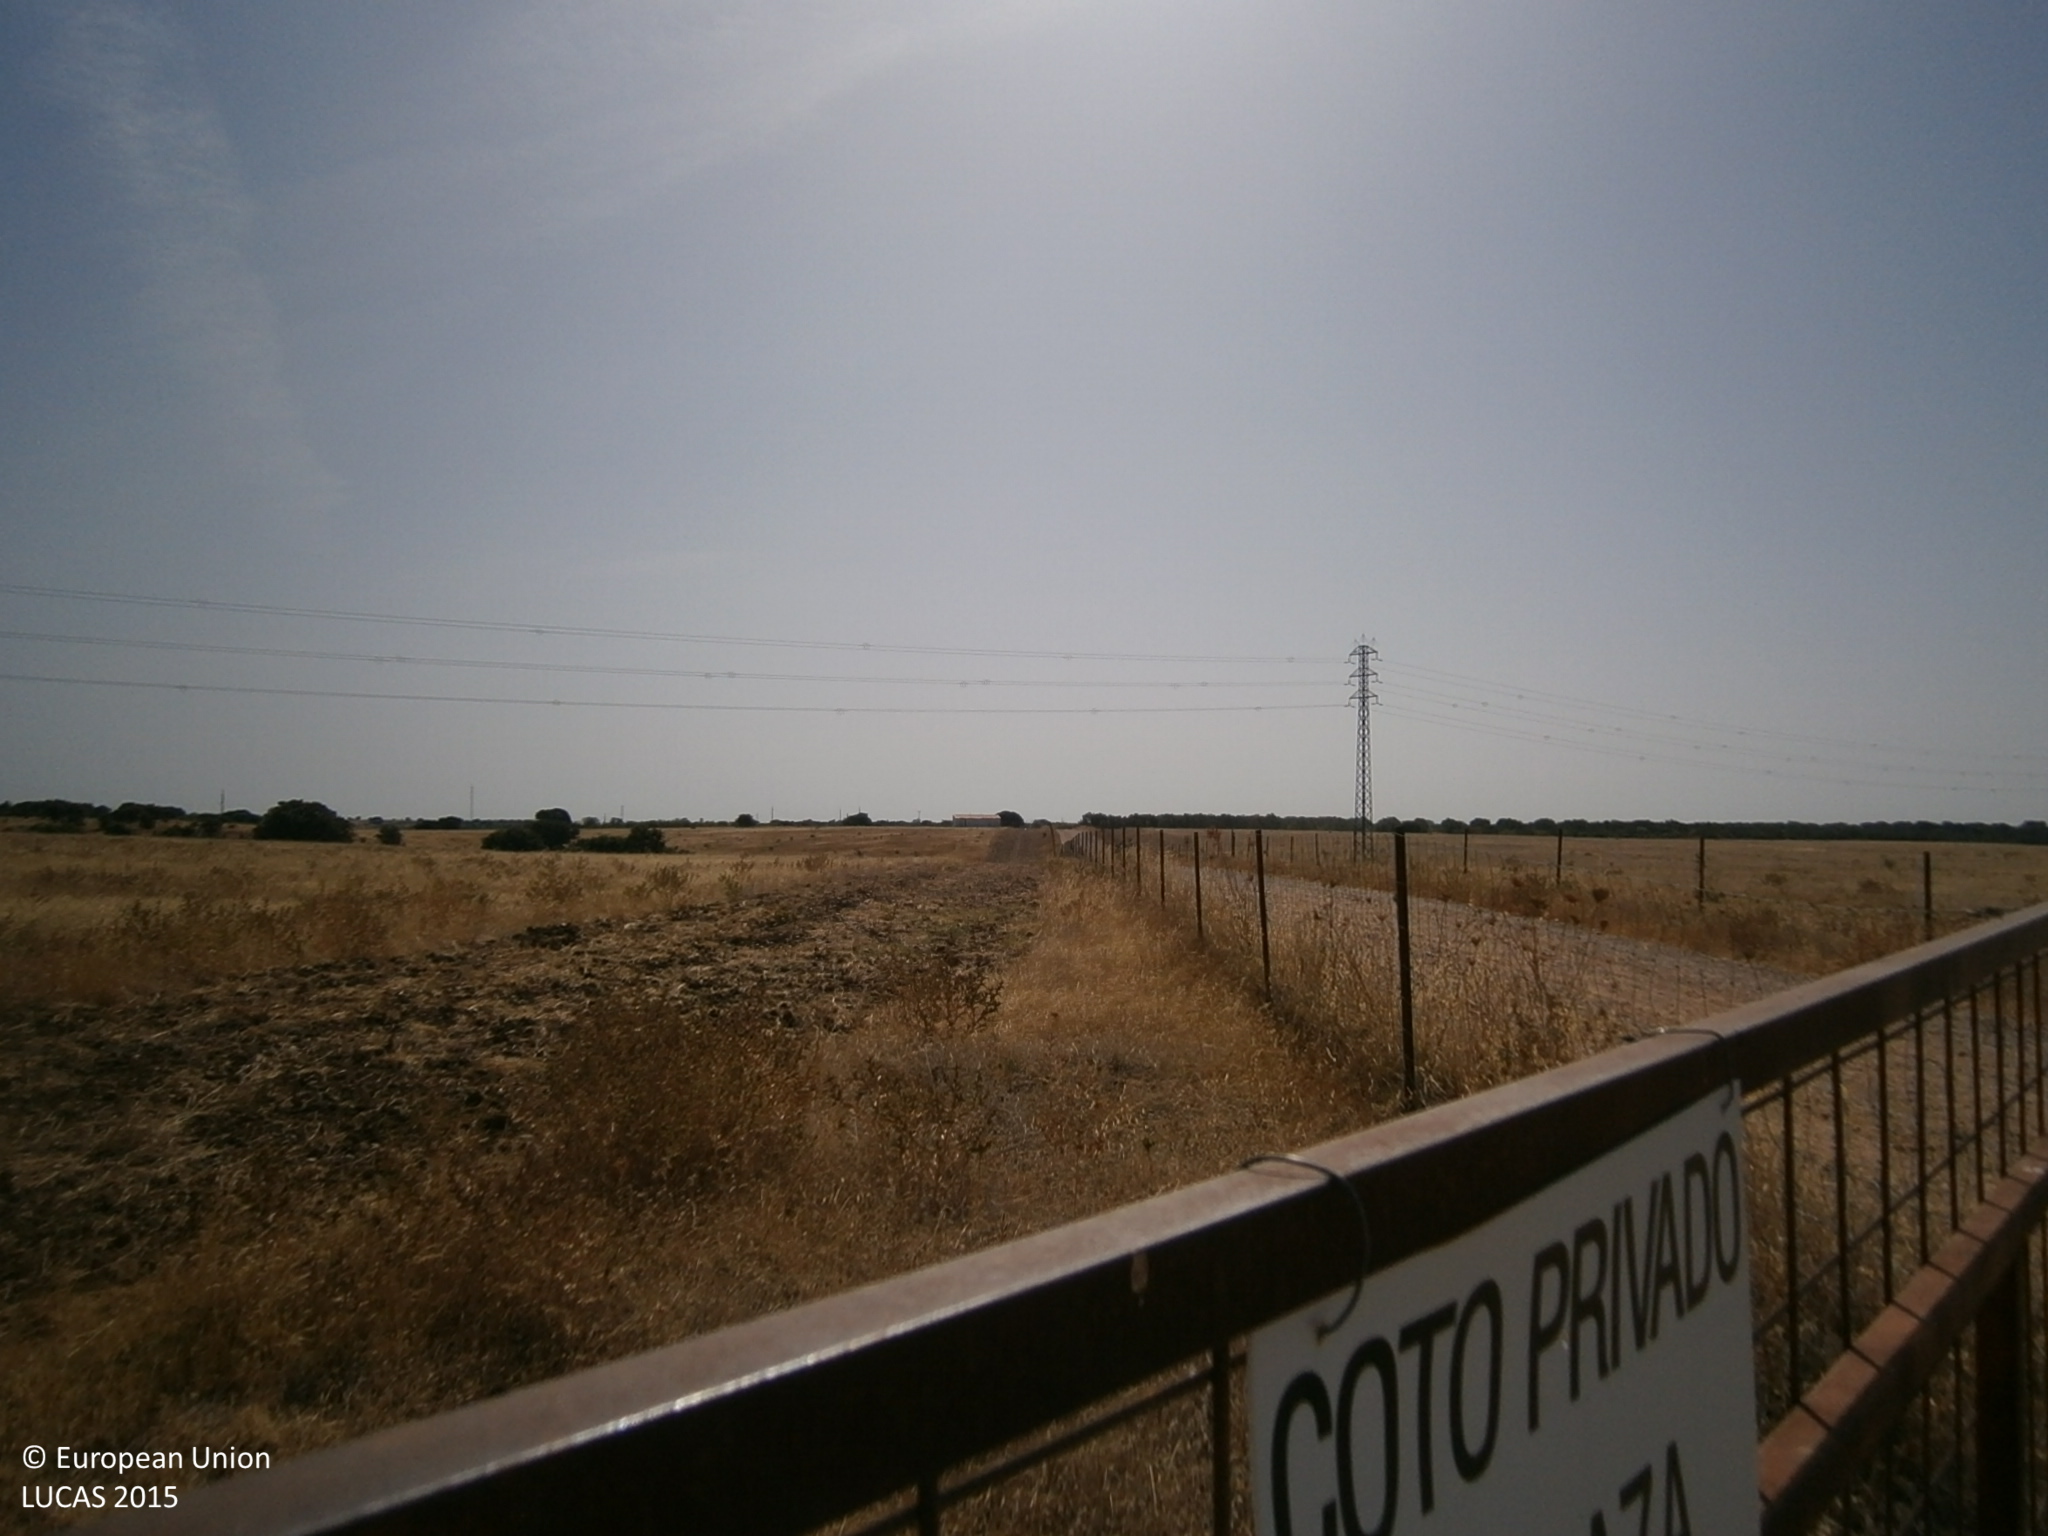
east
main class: Grassland
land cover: Grassland with sparse tree/shrub cover
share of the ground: > 75 %
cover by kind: herbaceous plants 70 %, shrubs 10 %, unconsolidated bare surface 10 %, broadleaved forest trees 5 %
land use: Agriculture (excluding fallow land and kitchen gardens)
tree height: > 5 m
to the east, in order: Grassland with sparse tree/shrub cover; Electric lines; Grassland with sparse tree/shrub cover; Fences; Other bare soil; Grassland with sparse tree/shrub cover
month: July
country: ES
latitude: 38.8797
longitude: -6.9098
